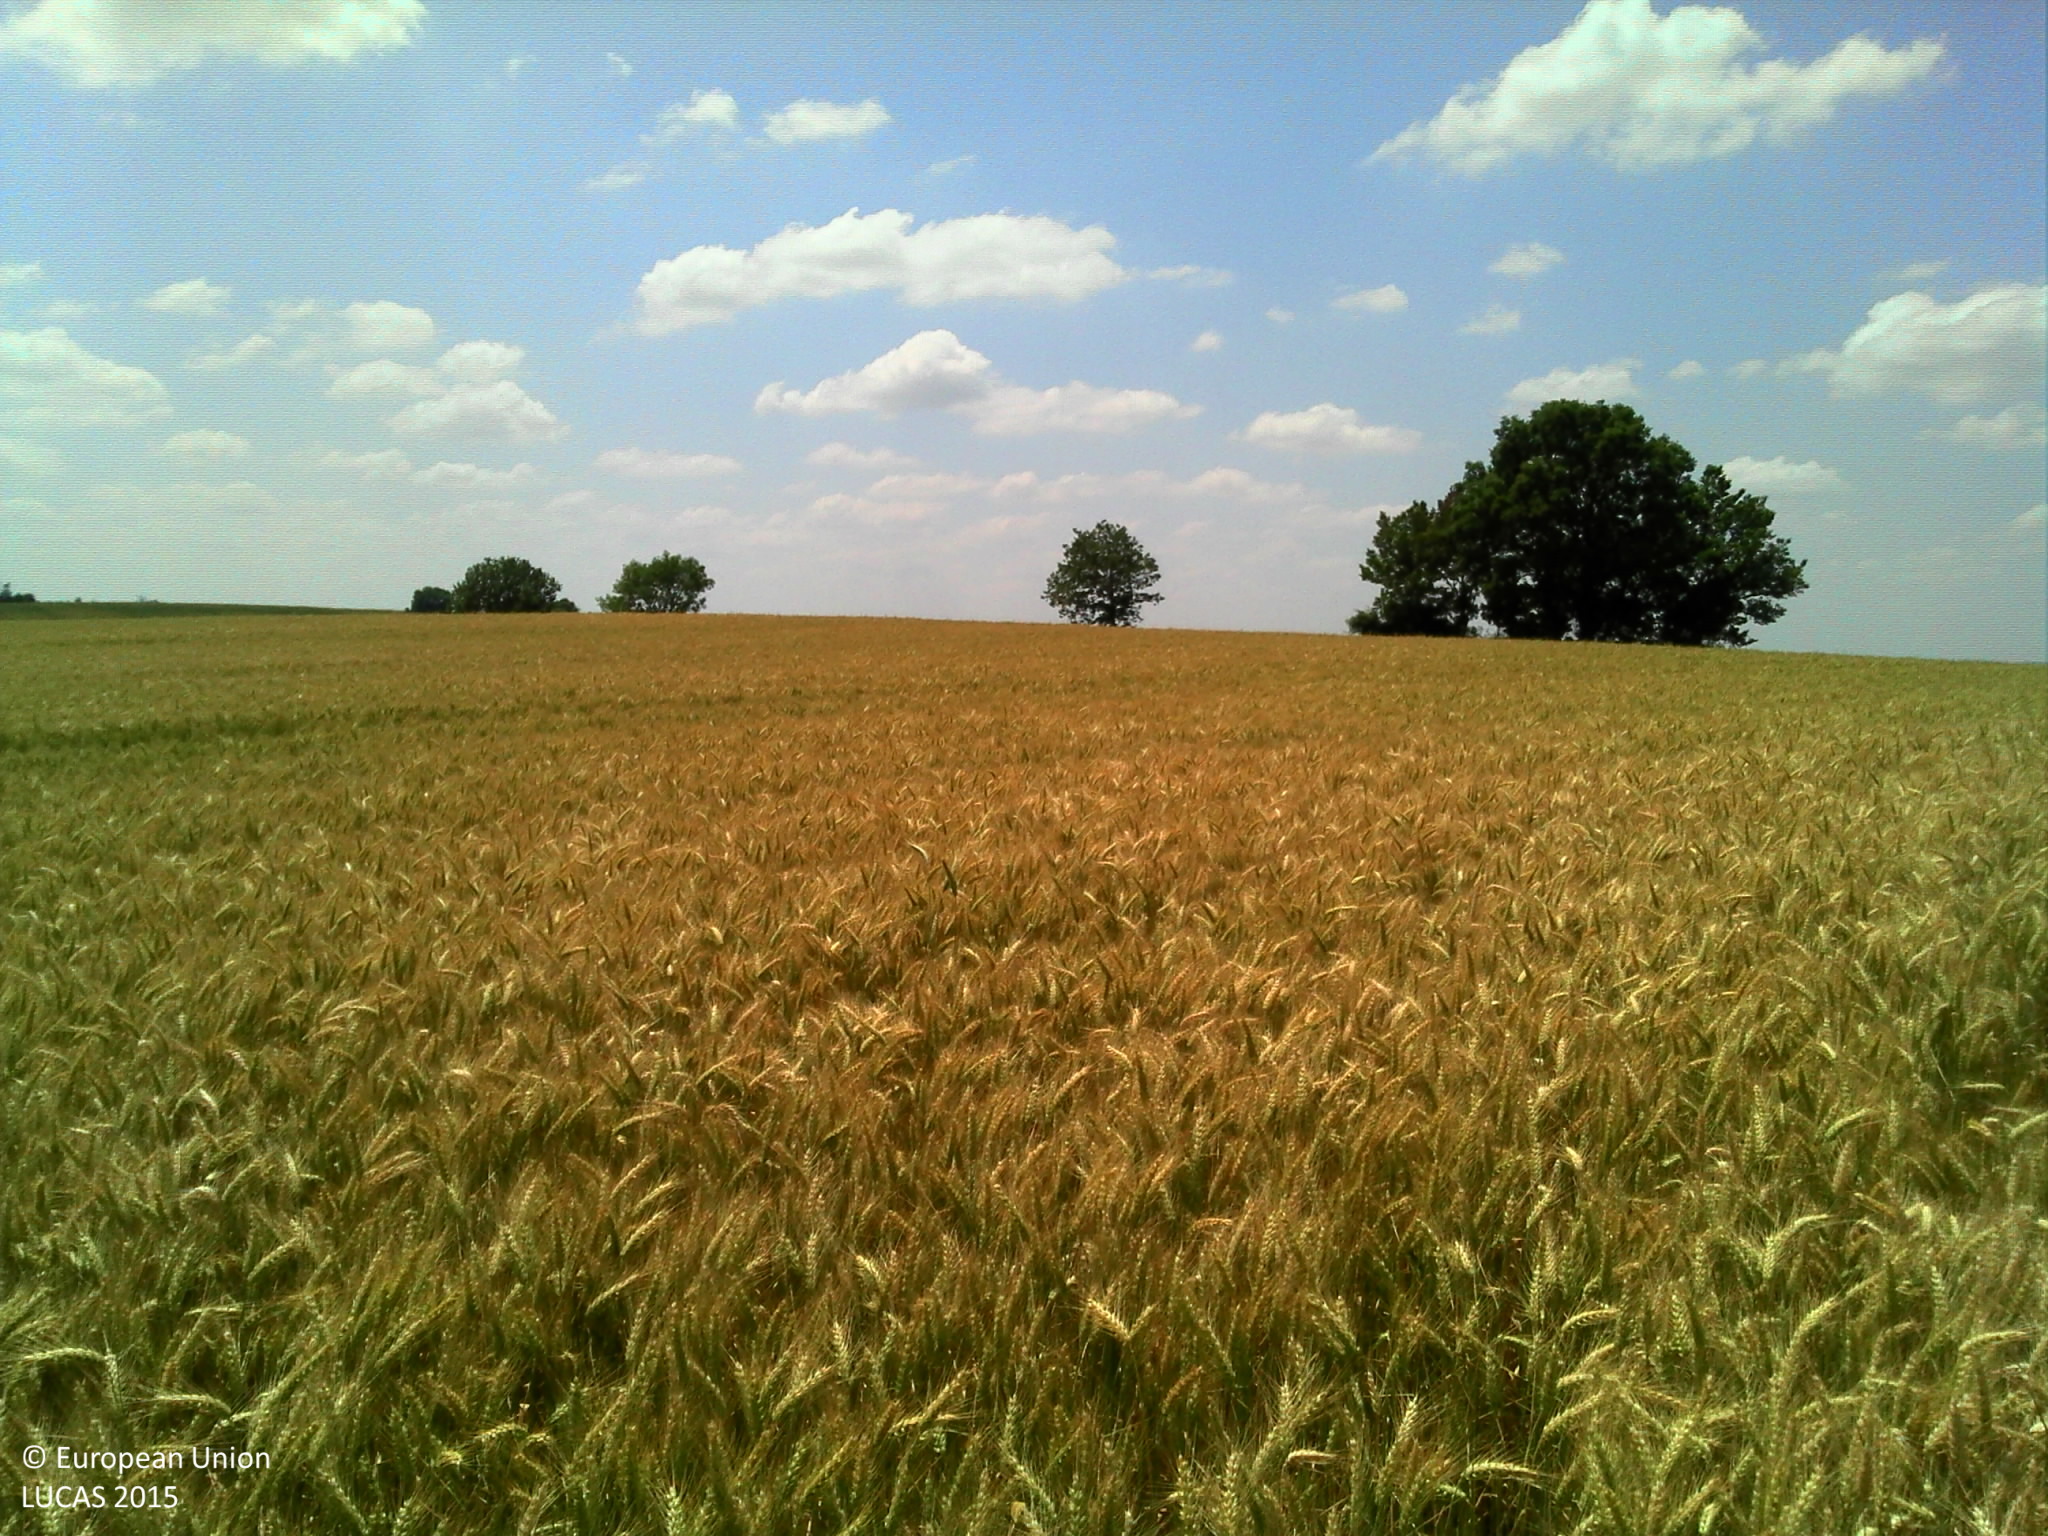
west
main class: Cropland
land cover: Durum wheat
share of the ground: > 75 %
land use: Agriculture (excluding fallow land and kitchen gardens)
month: June
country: FR
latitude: 43.7905
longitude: 0.7395
